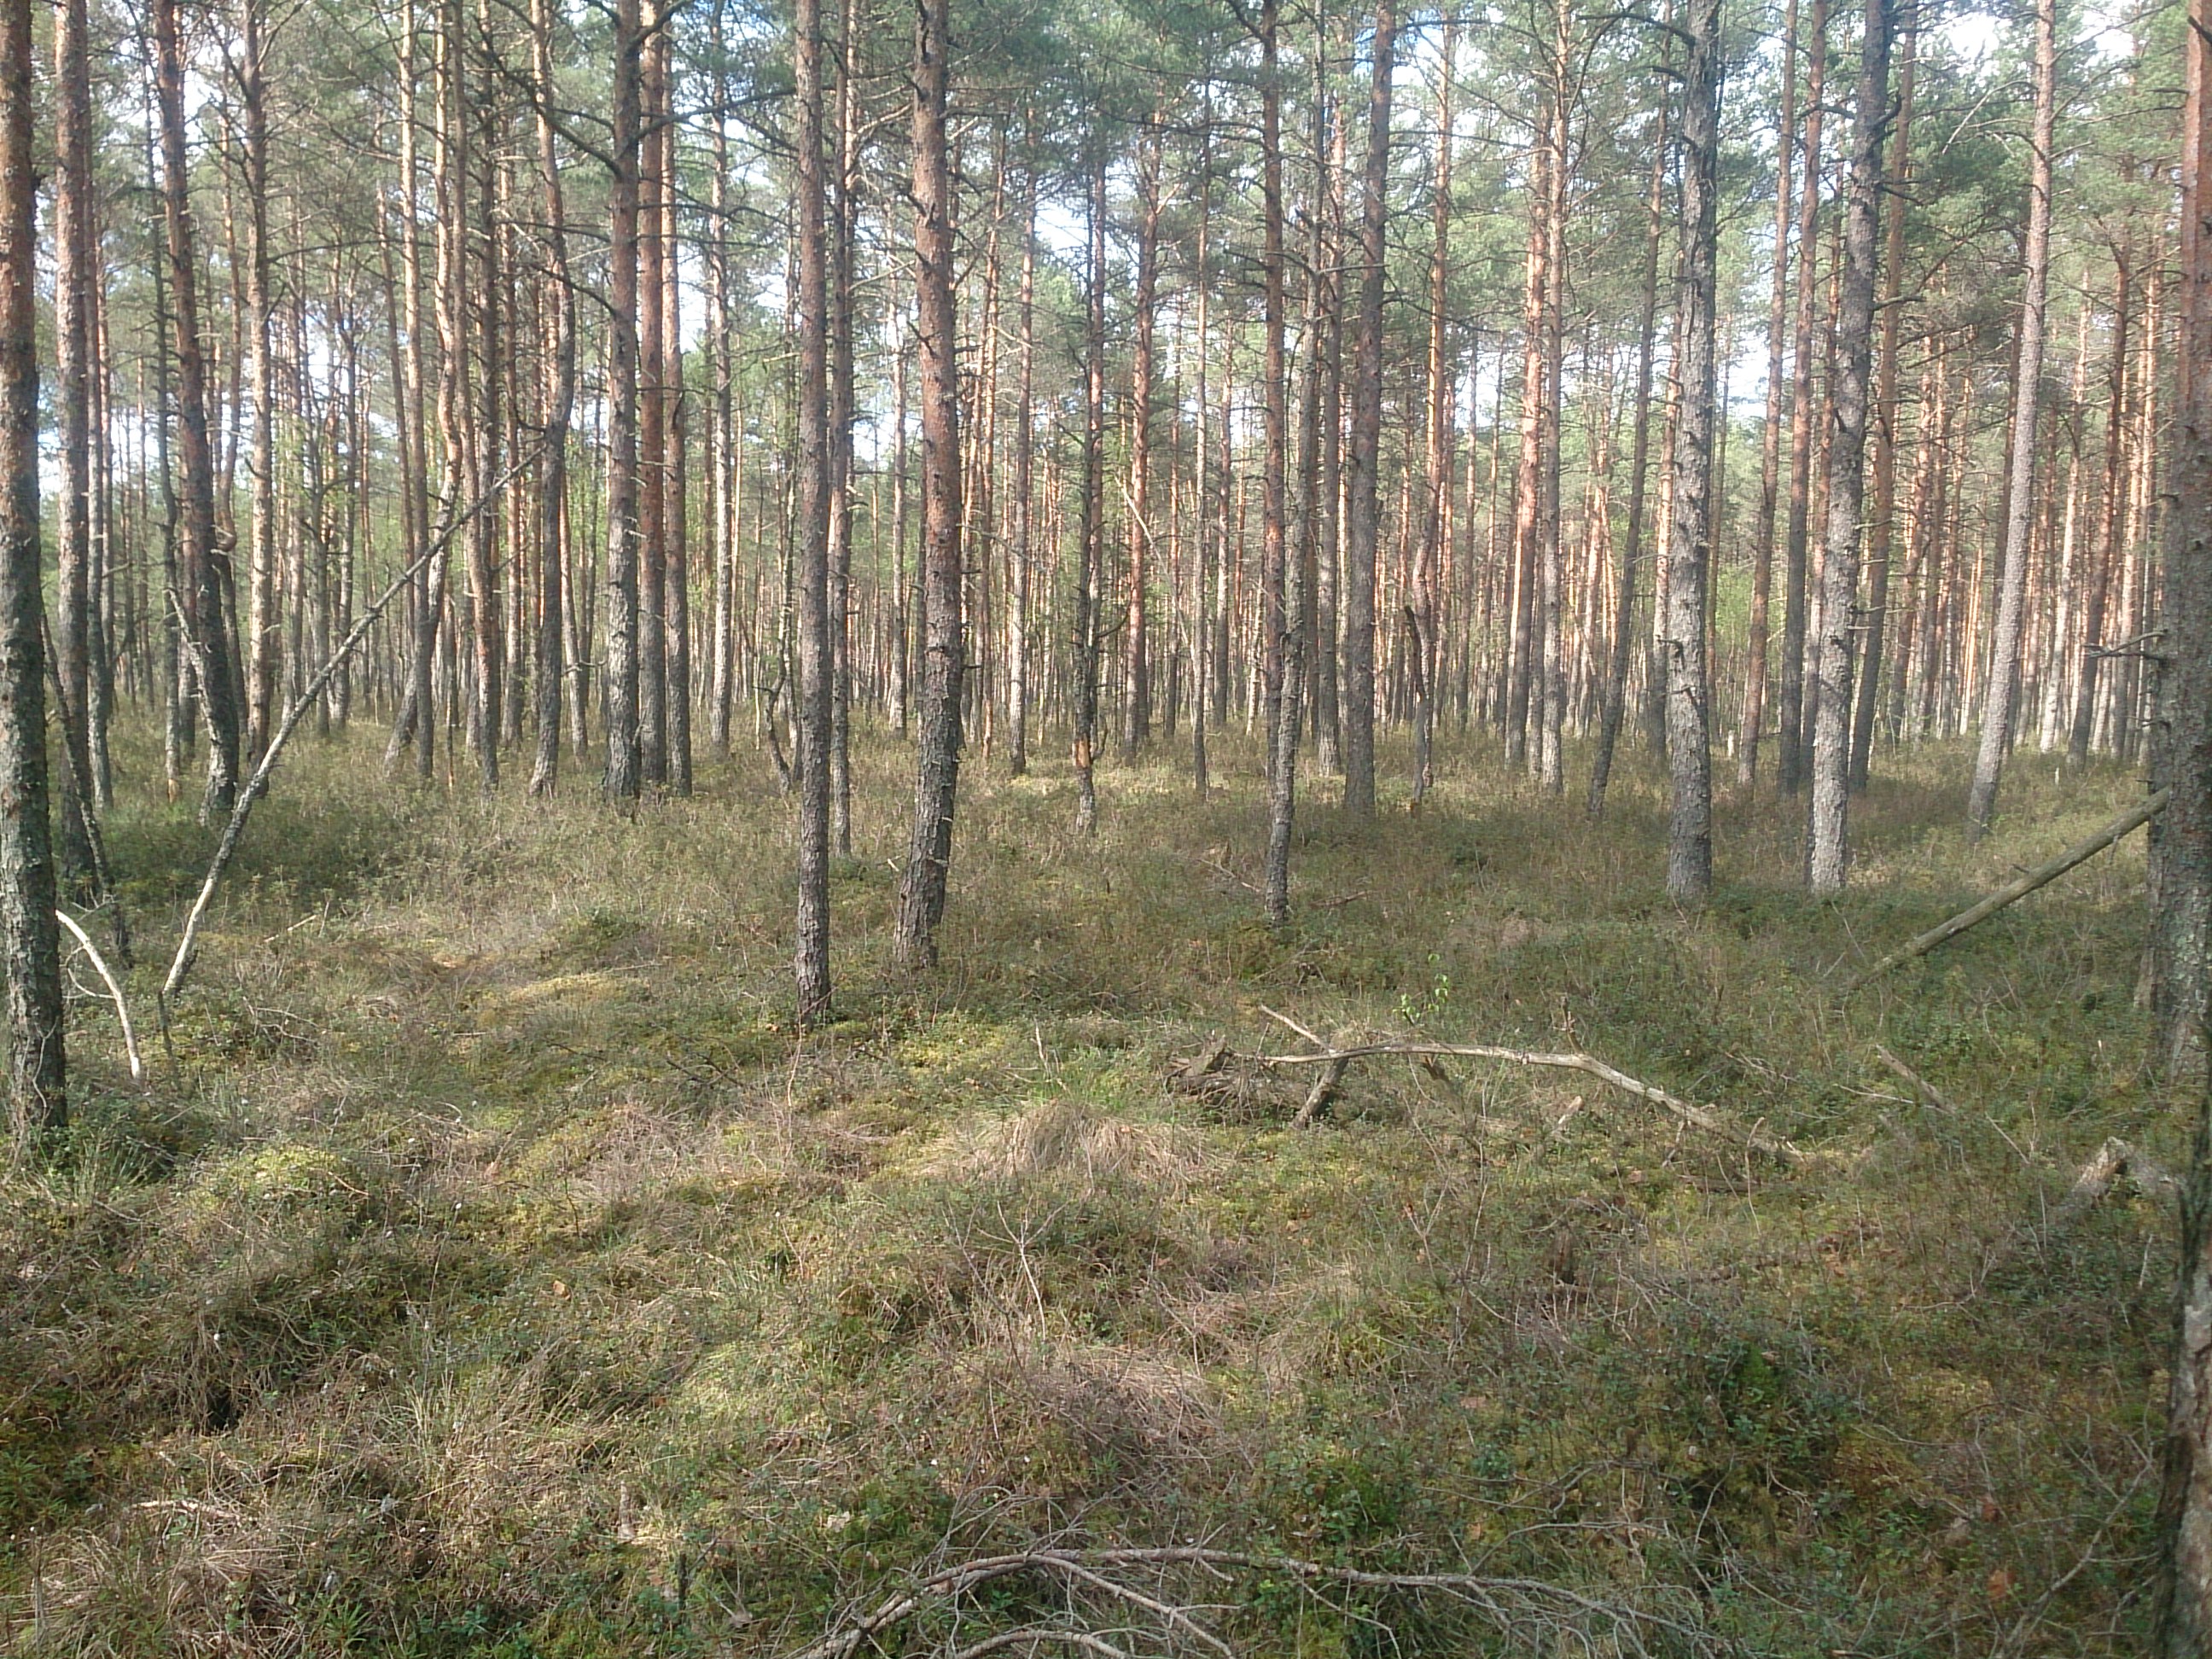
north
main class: Woodland
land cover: Pine dominated coniferous woodland
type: mire and swamp forests
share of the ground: > 75 %
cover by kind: coniferous forest trees 80 %, lichens and mosses 20 %
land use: Semi-natural and natural areas not in use
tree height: > 5 m
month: May
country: LV
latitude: 56.7920
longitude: 24.1166
